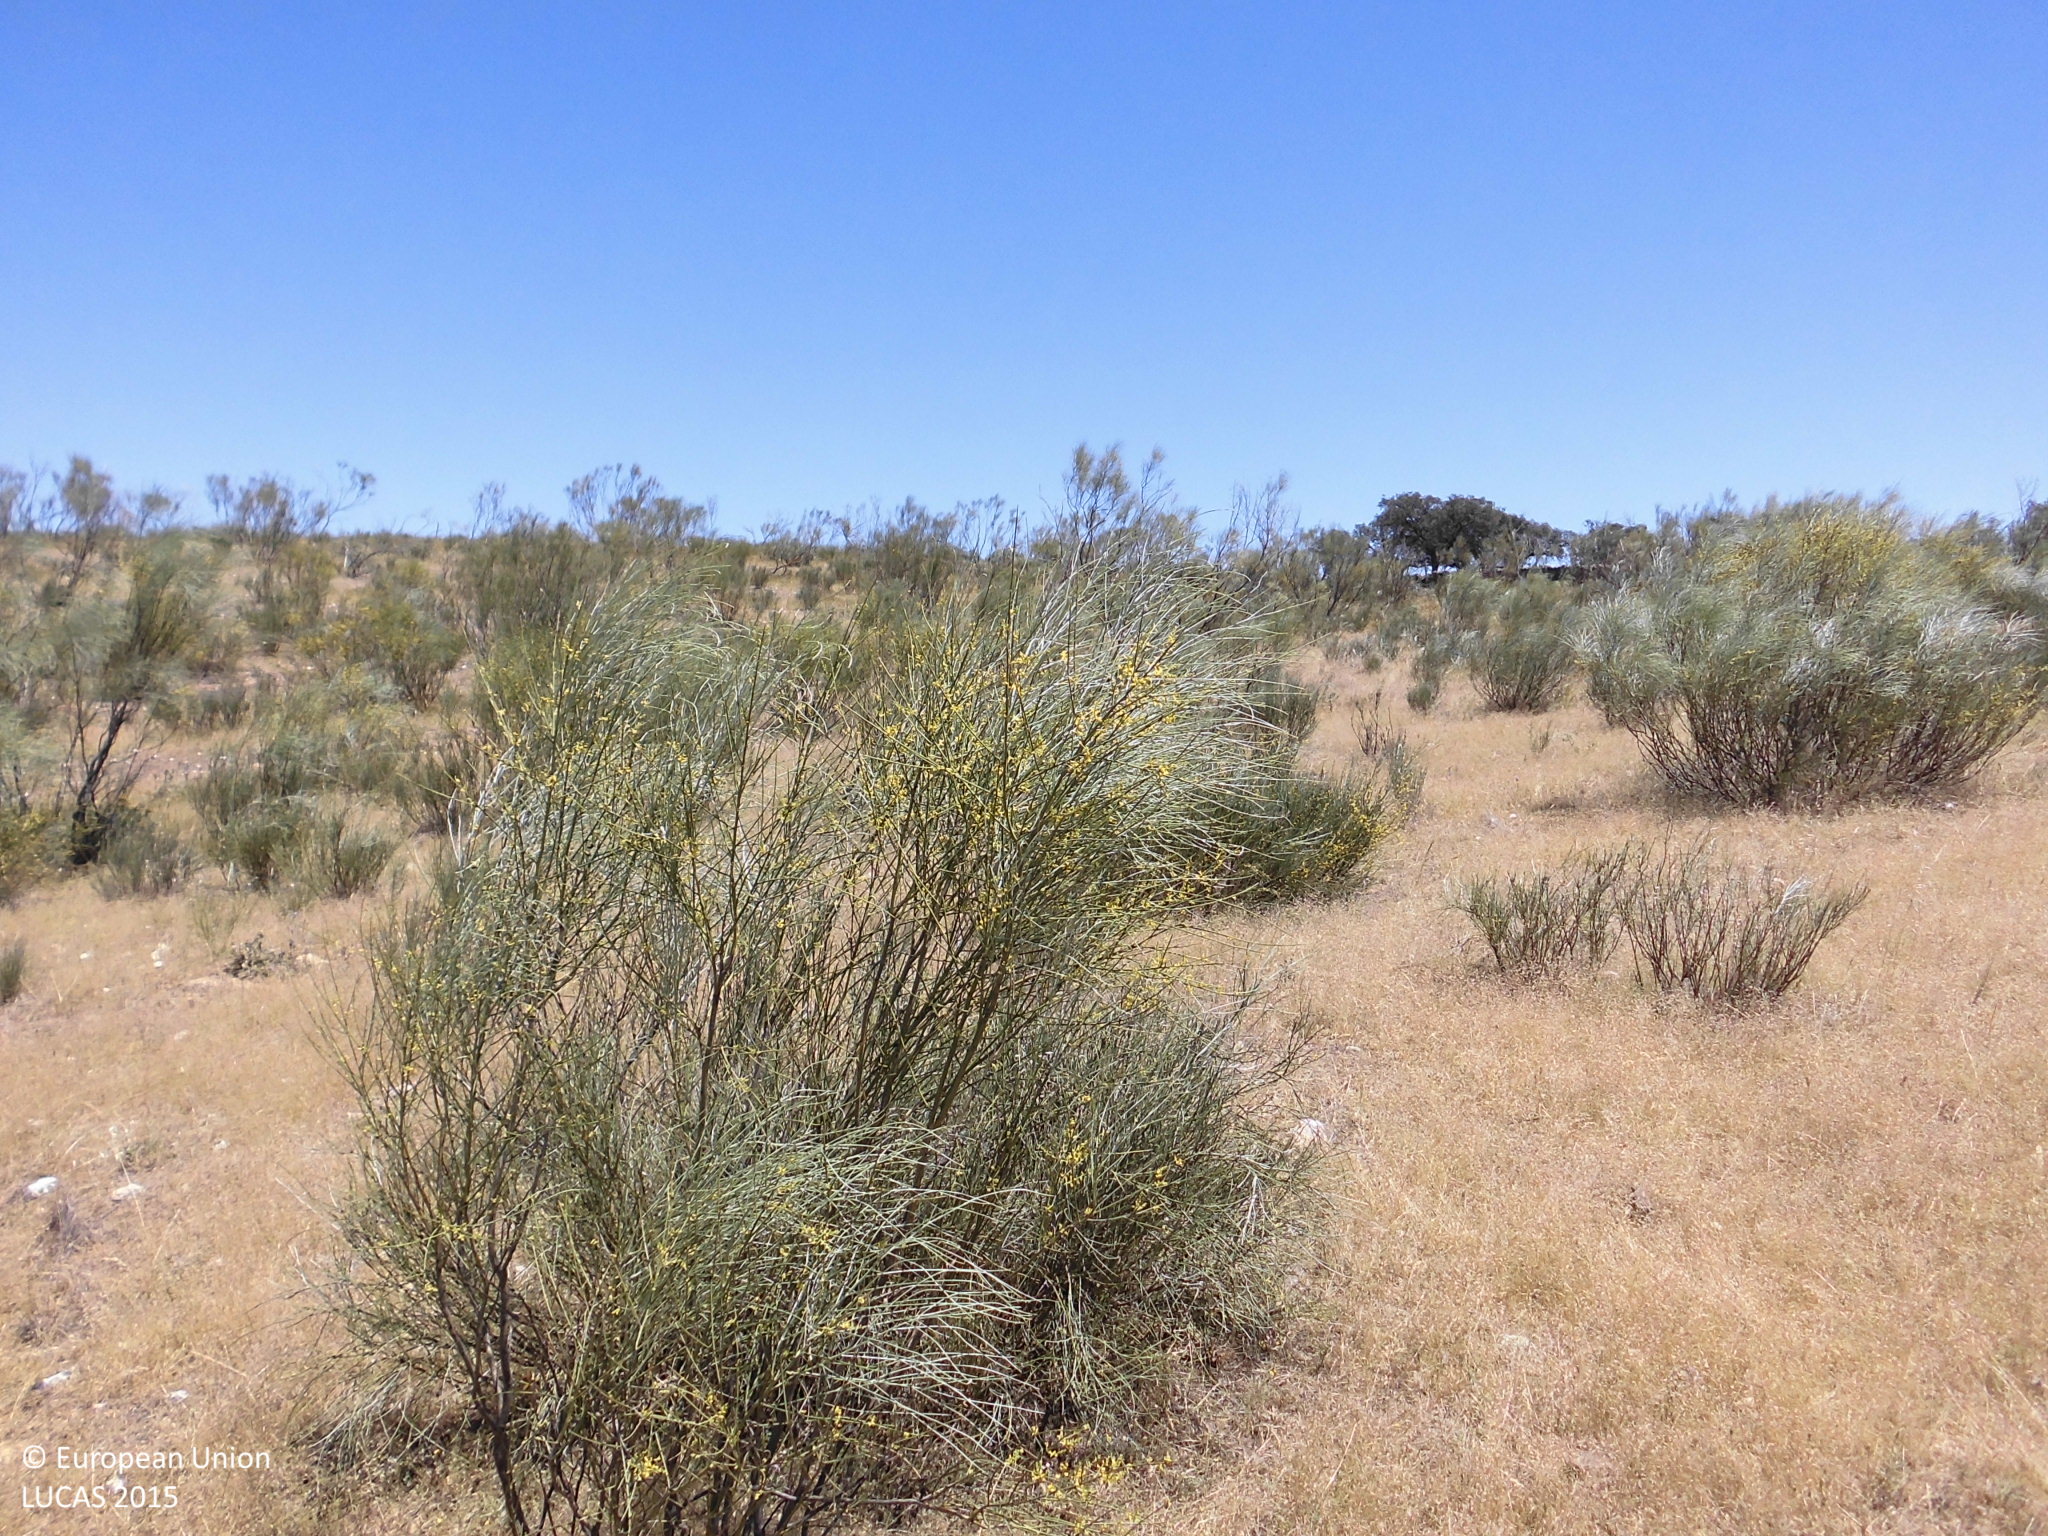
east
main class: Shrubland
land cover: Shrubland without tree cover
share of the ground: 10 - 25 %
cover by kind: herbaceous plants 85 %, shrubs 15 %
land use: Agriculture (excluding fallow land and kitchen gardens)
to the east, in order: Shrubland without tree cover; Tracks; Shrubland without tree cover
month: May
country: ES
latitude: 39.4852
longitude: -6.9266
